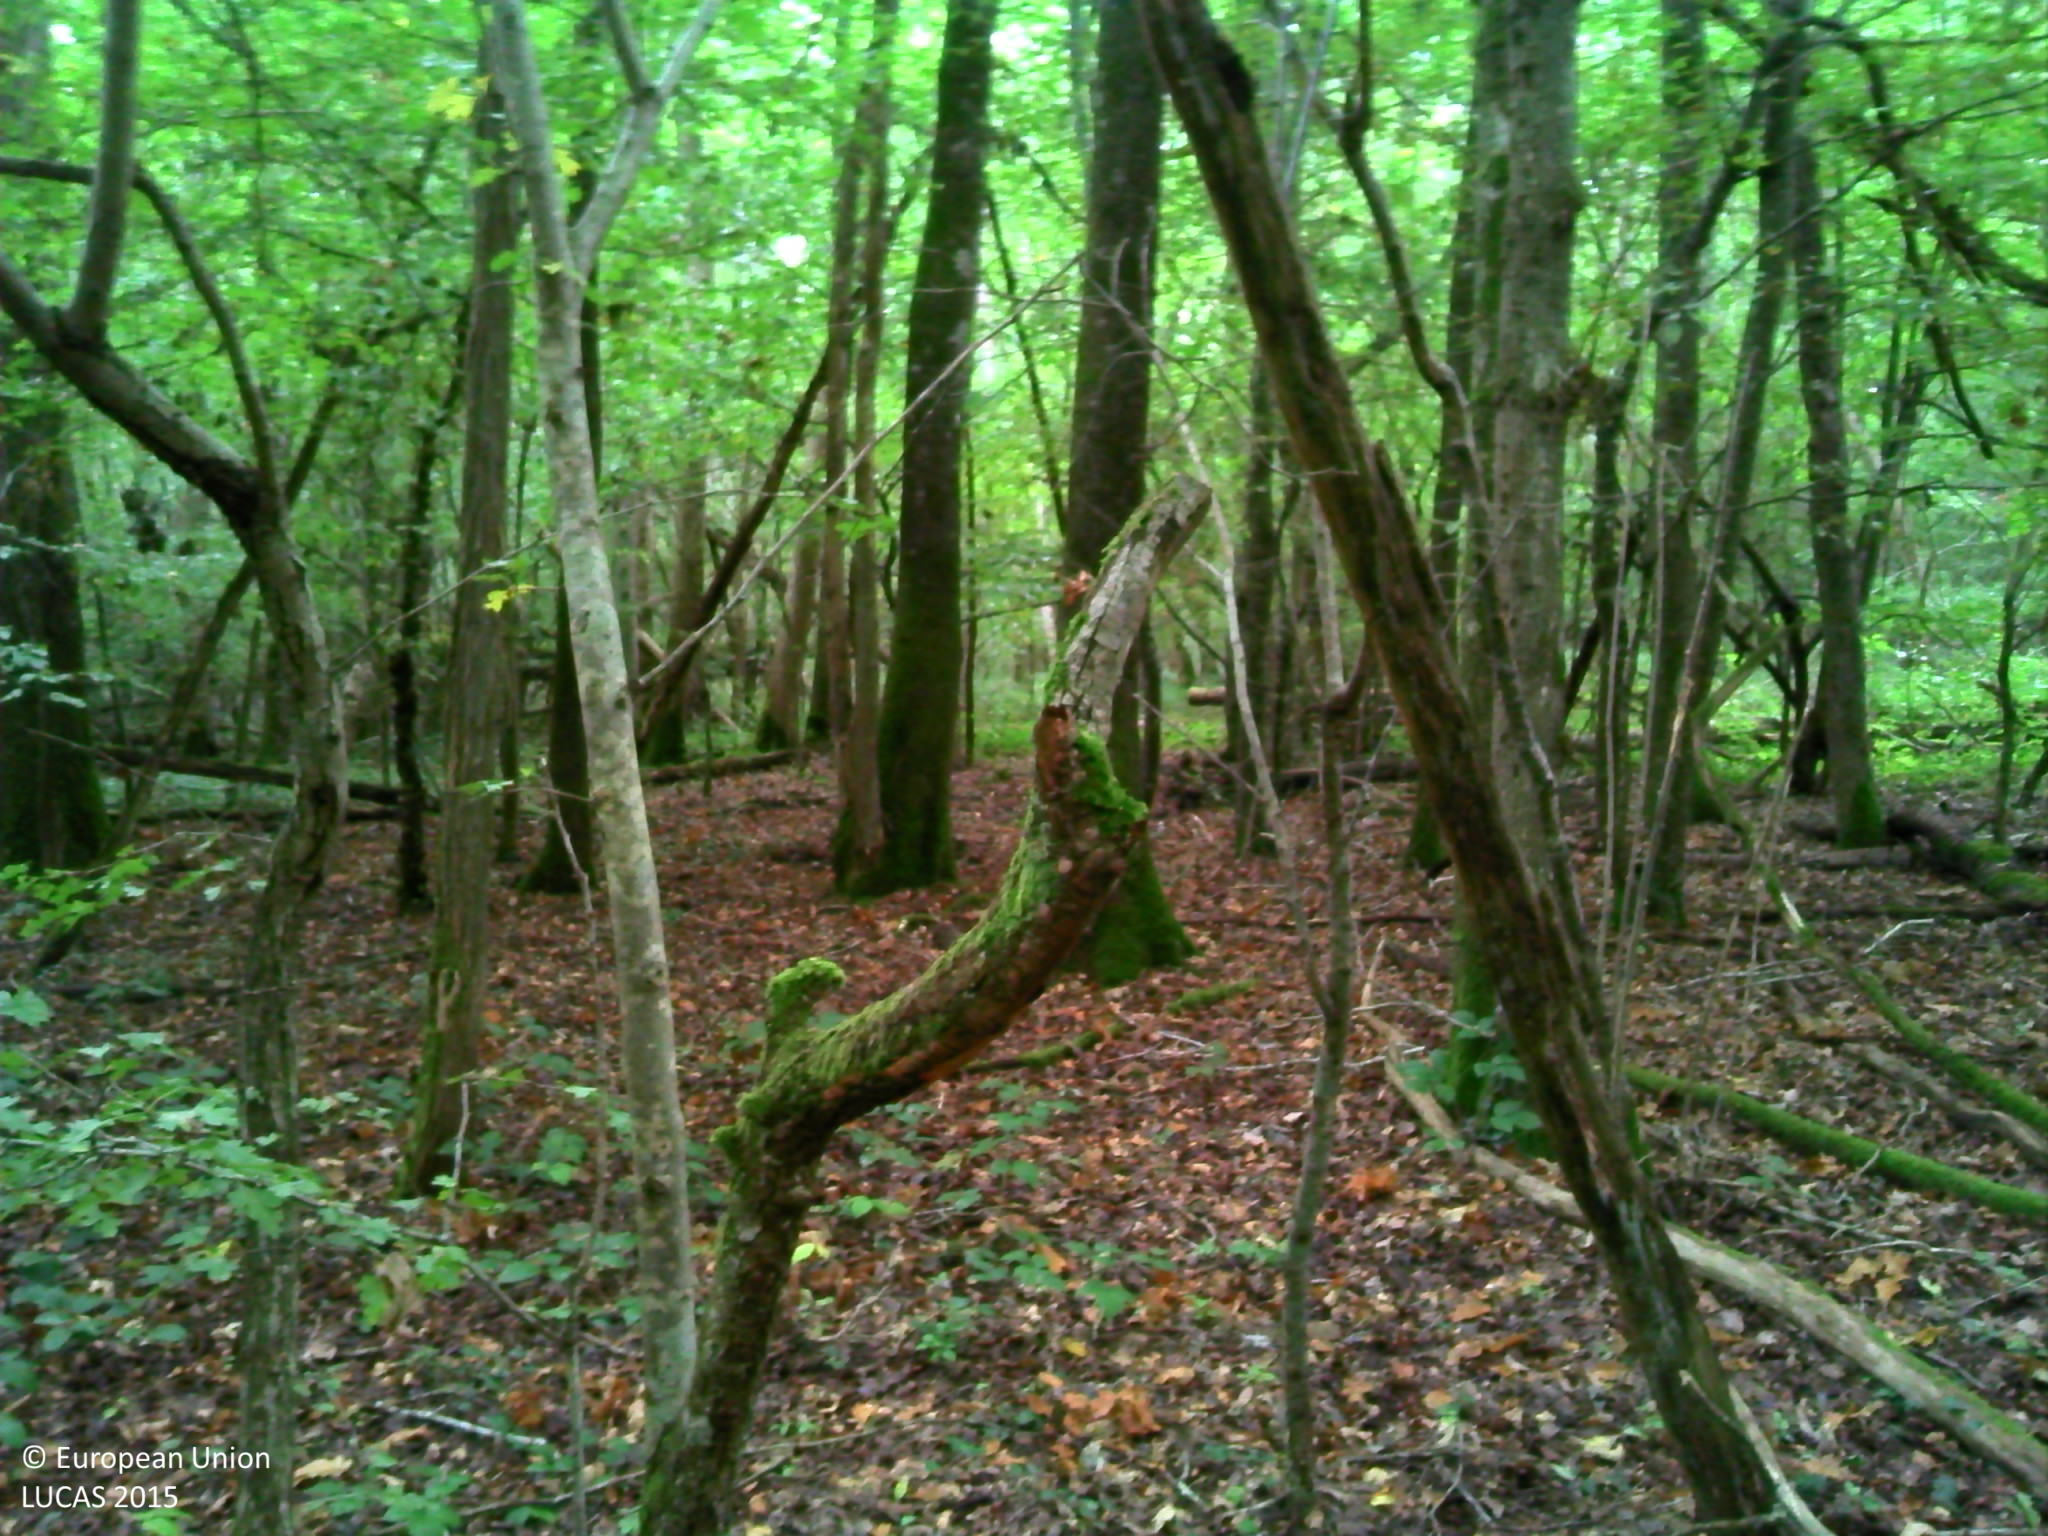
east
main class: Woodland
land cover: Broadleaved woodland
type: acidophilous oak and oak-birch forest
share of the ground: > 75 %
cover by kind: broadleaved forest trees 85 %, shrubs 5 %, herbaceous plants 5 %, lichens and mosses 5 %
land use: Forestry
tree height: > 5 m
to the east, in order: Broadleaved woodland; Tracks; Broadleaved woodland; Grassland without tree/shrub cover; Rape and turnip rape
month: October
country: FR
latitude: 48.2735
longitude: 3.0265
